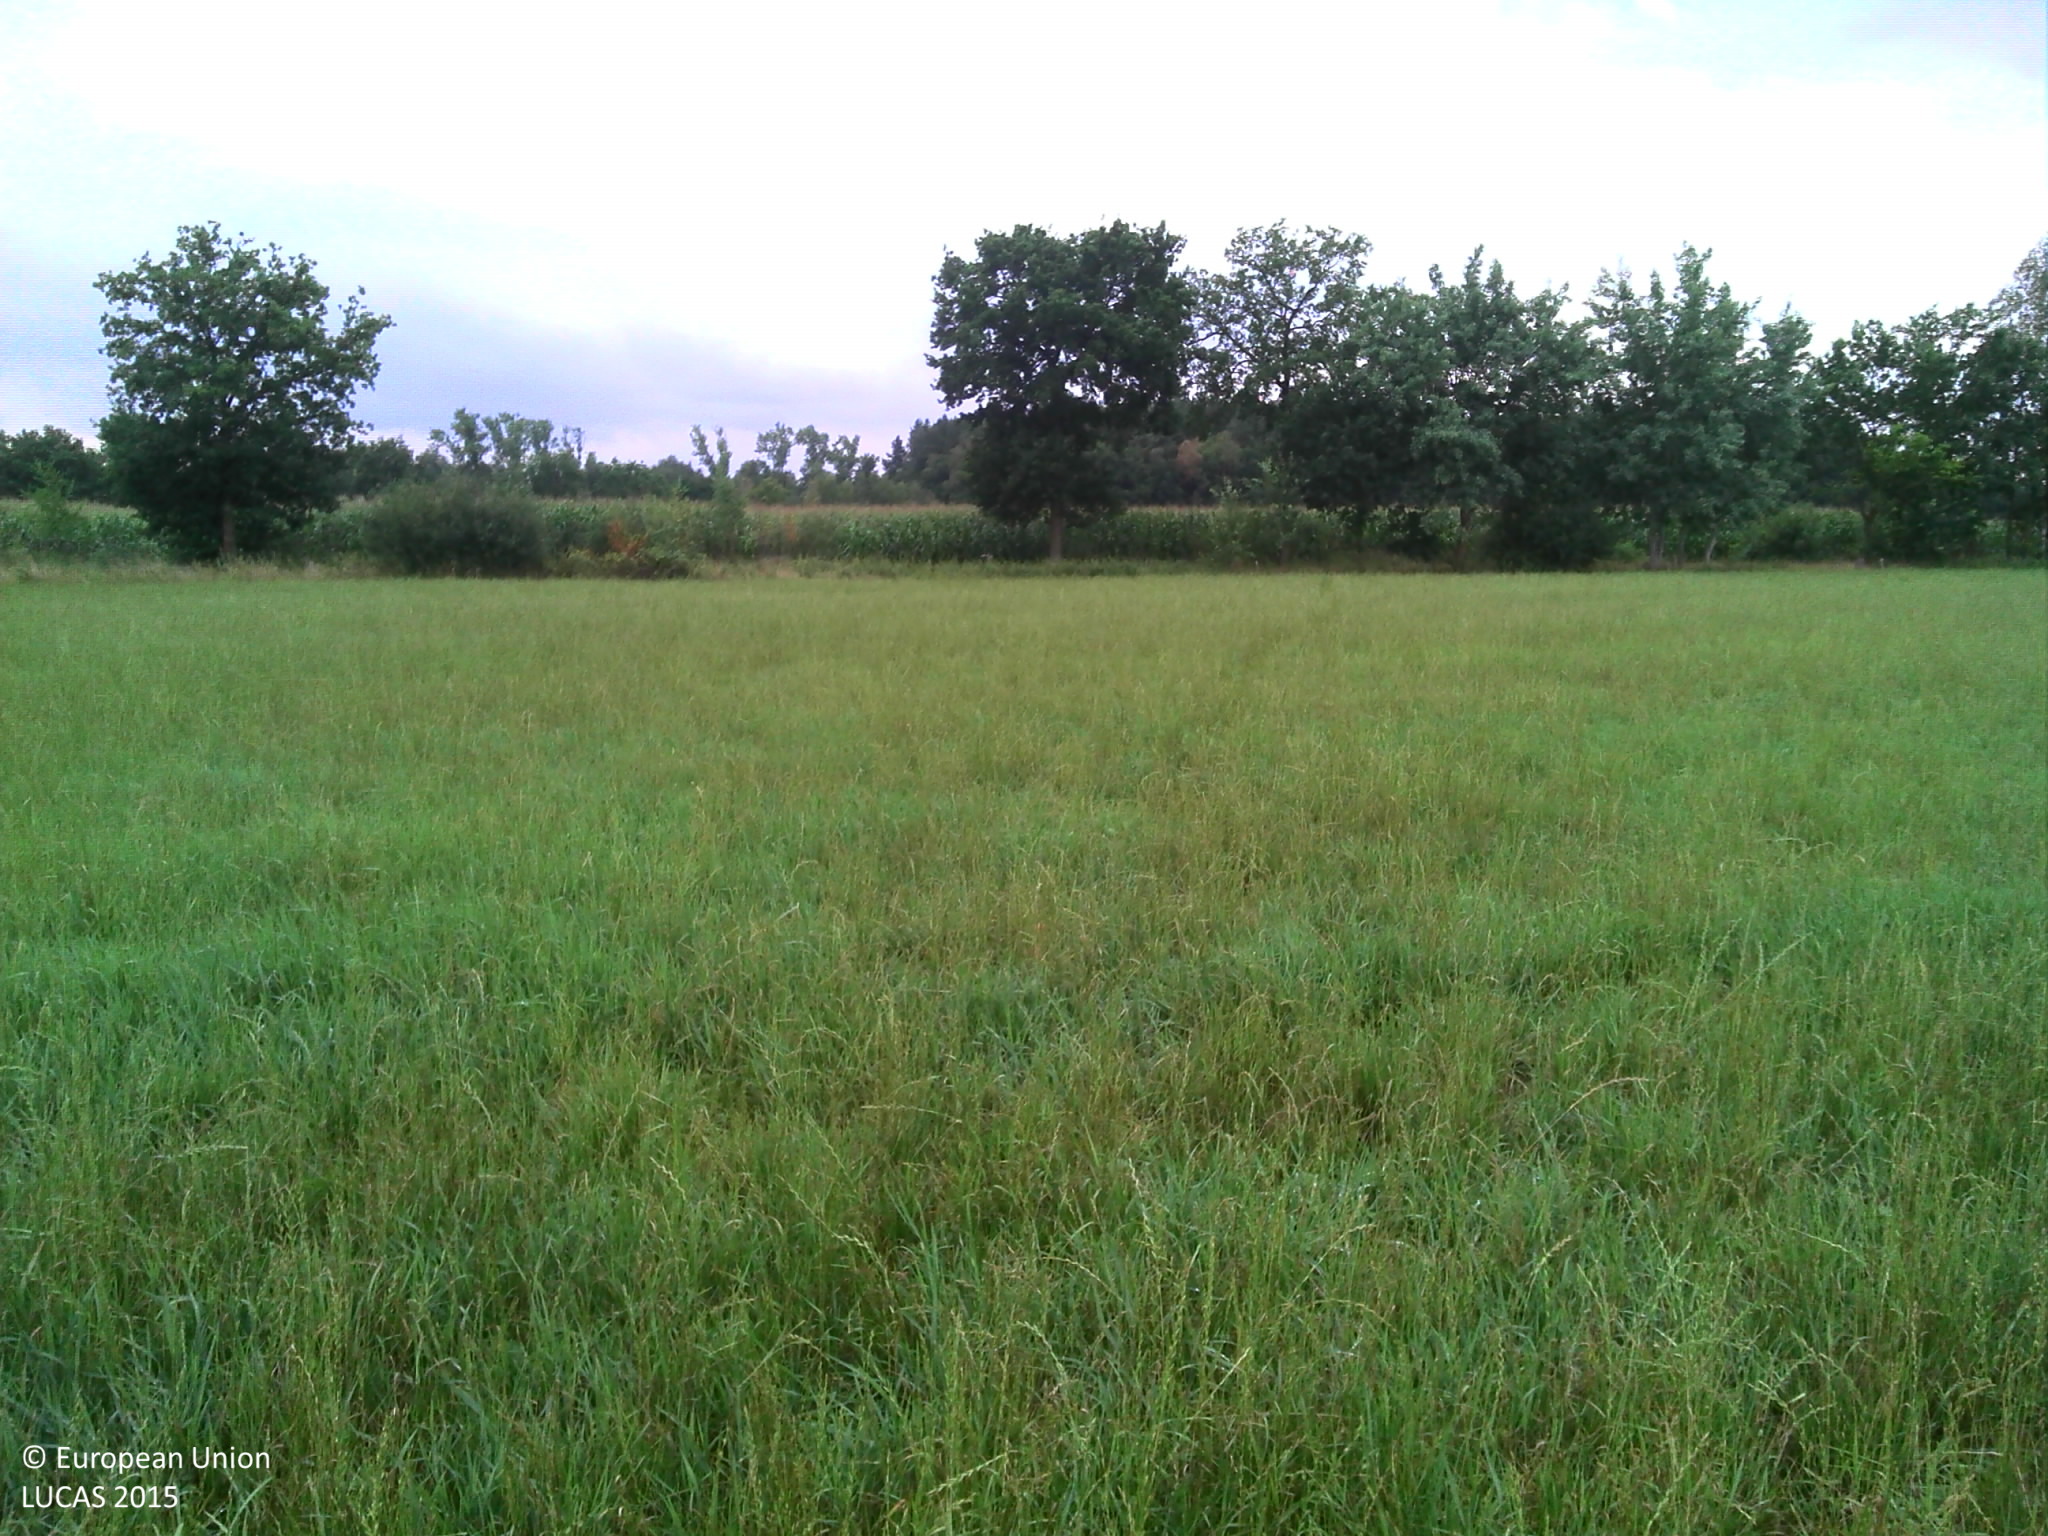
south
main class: Grassland
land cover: Grassland without tree/shrub cover
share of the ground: > 75 %
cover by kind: herbaceous plants 100 %
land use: Agriculture (excluding fallow land and kitchen gardens)
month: August
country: BE
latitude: 51.2874
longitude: 5.1366
